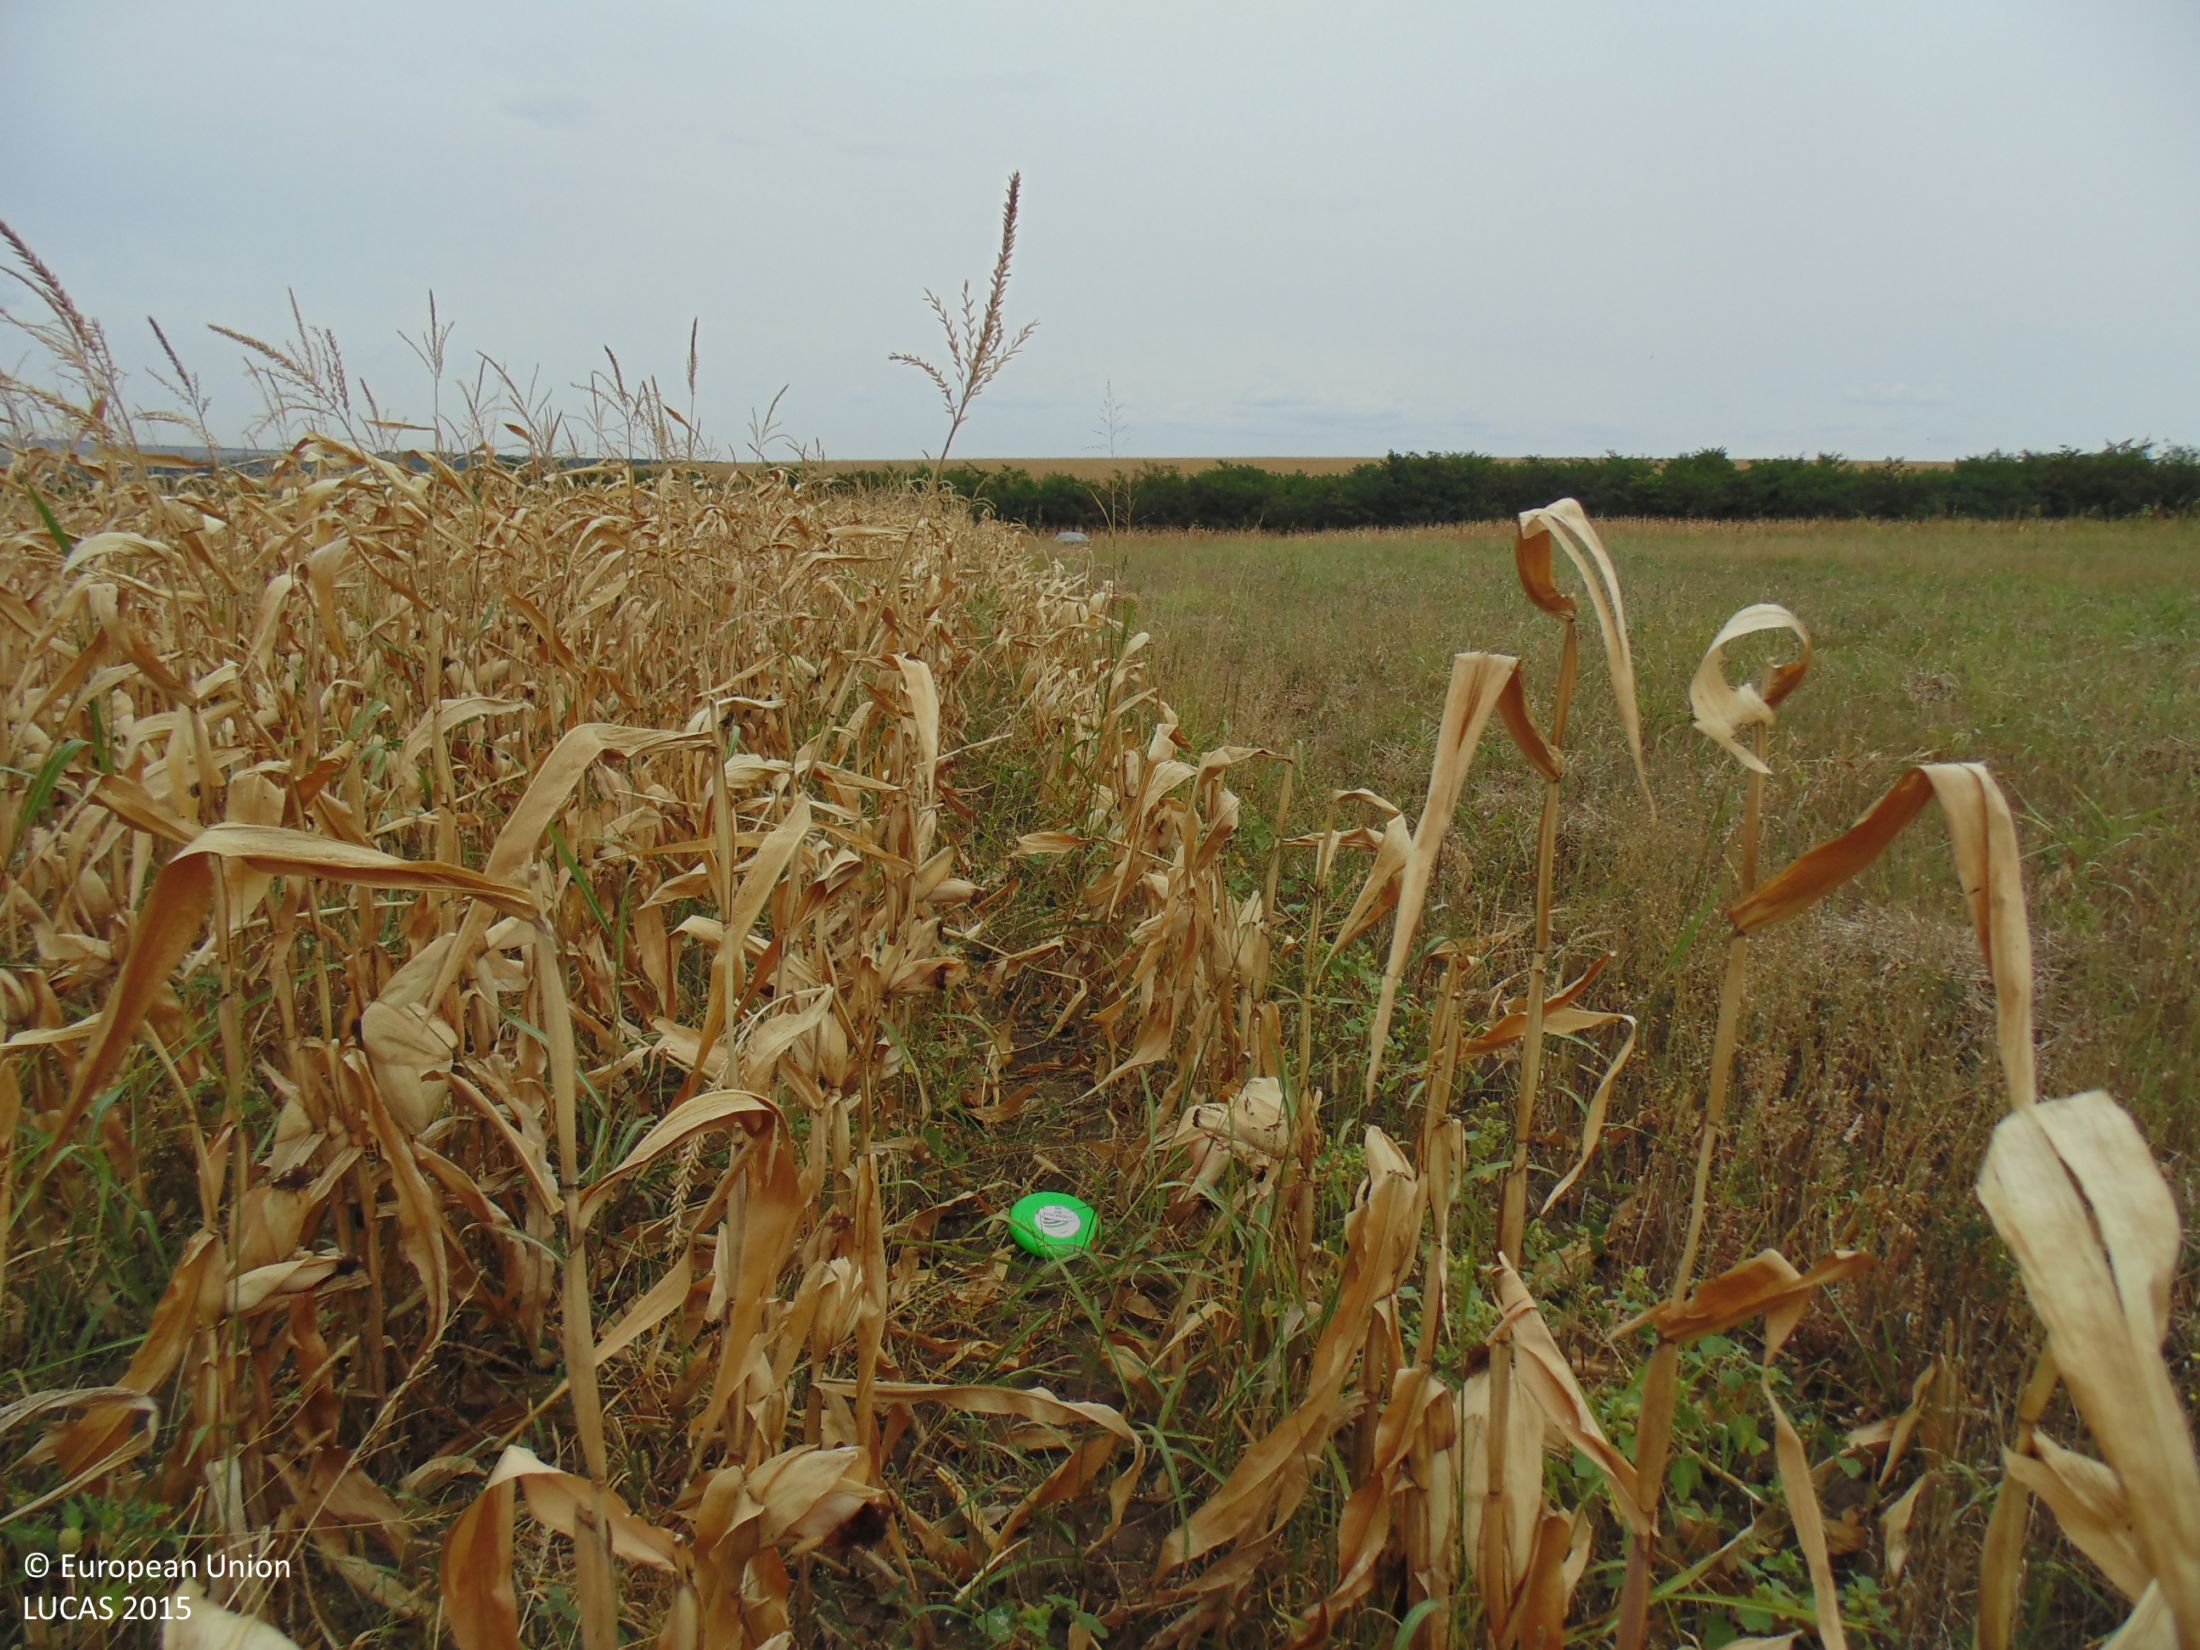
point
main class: Cropland
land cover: Maize
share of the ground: > 75 %
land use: Agriculture (excluding fallow land and kitchen gardens)
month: September
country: BG
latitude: 43.9557
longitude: 27.0597
